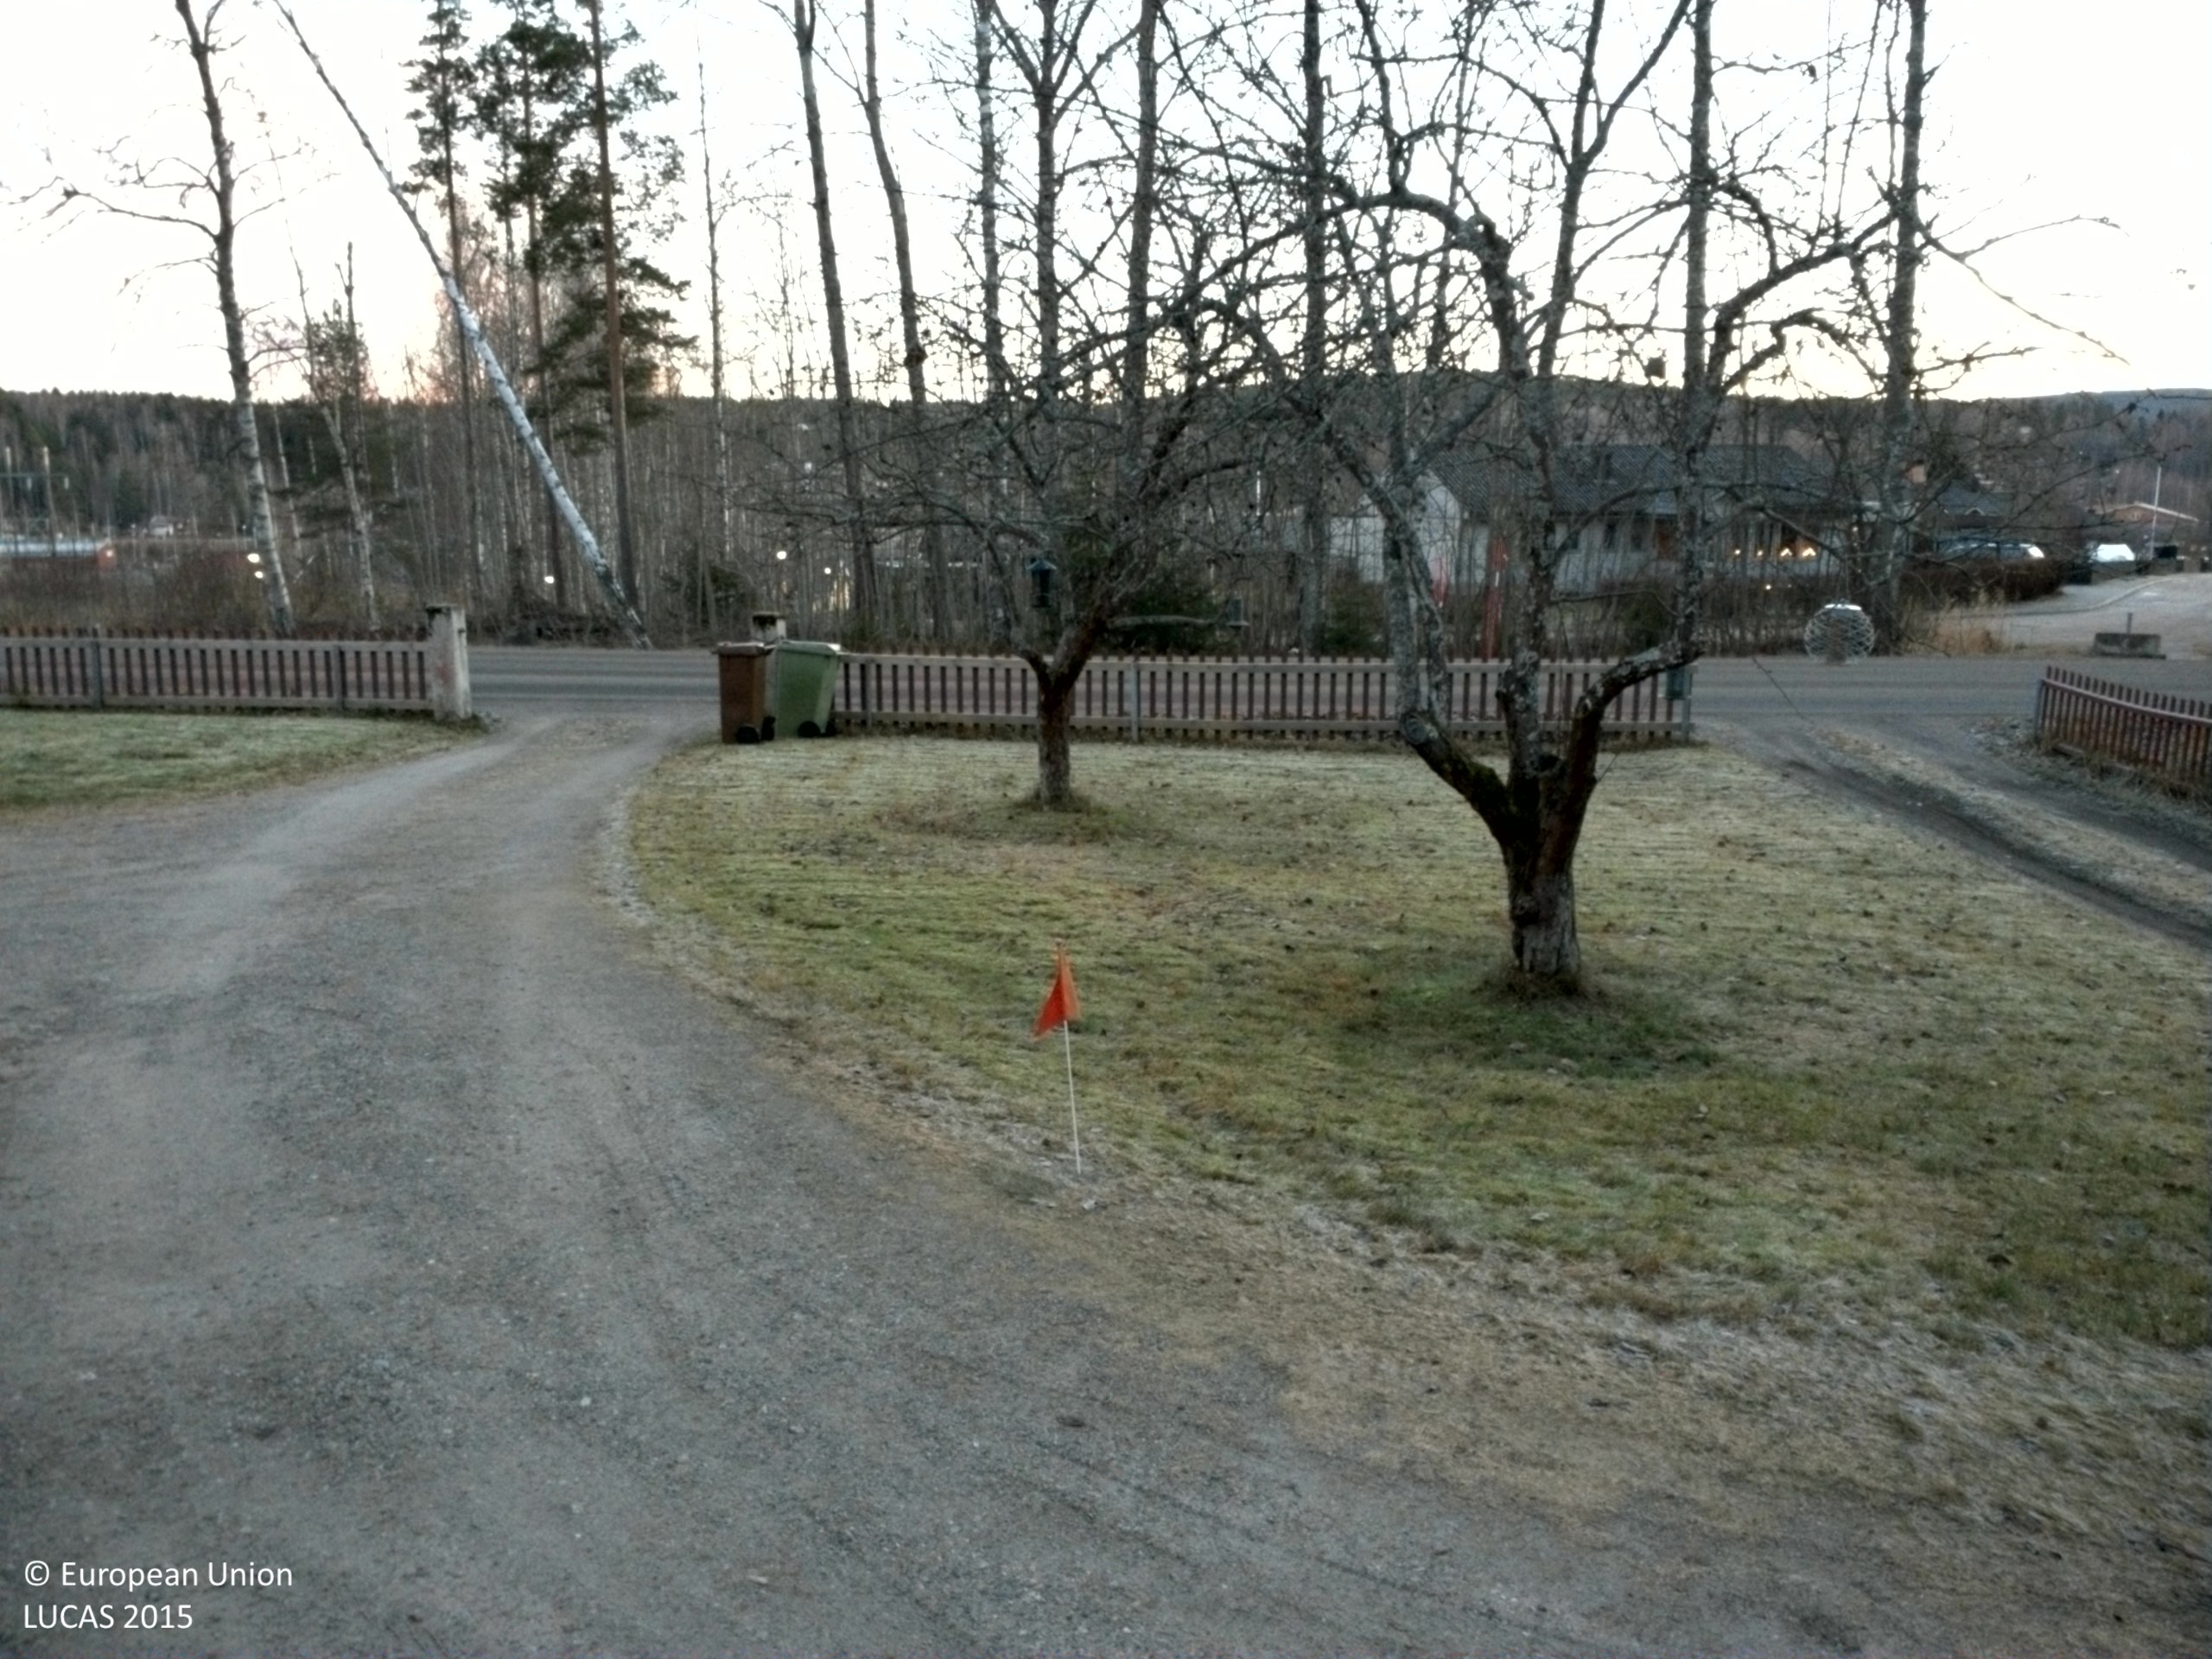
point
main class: Woodland
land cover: Broadleaved woodland
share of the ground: 10 - 25 %
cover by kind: herbaceous plants 85 %, broadleaved forest trees 15 %
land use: Residential
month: November
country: SE
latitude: 61.2630
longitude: 16.8284
